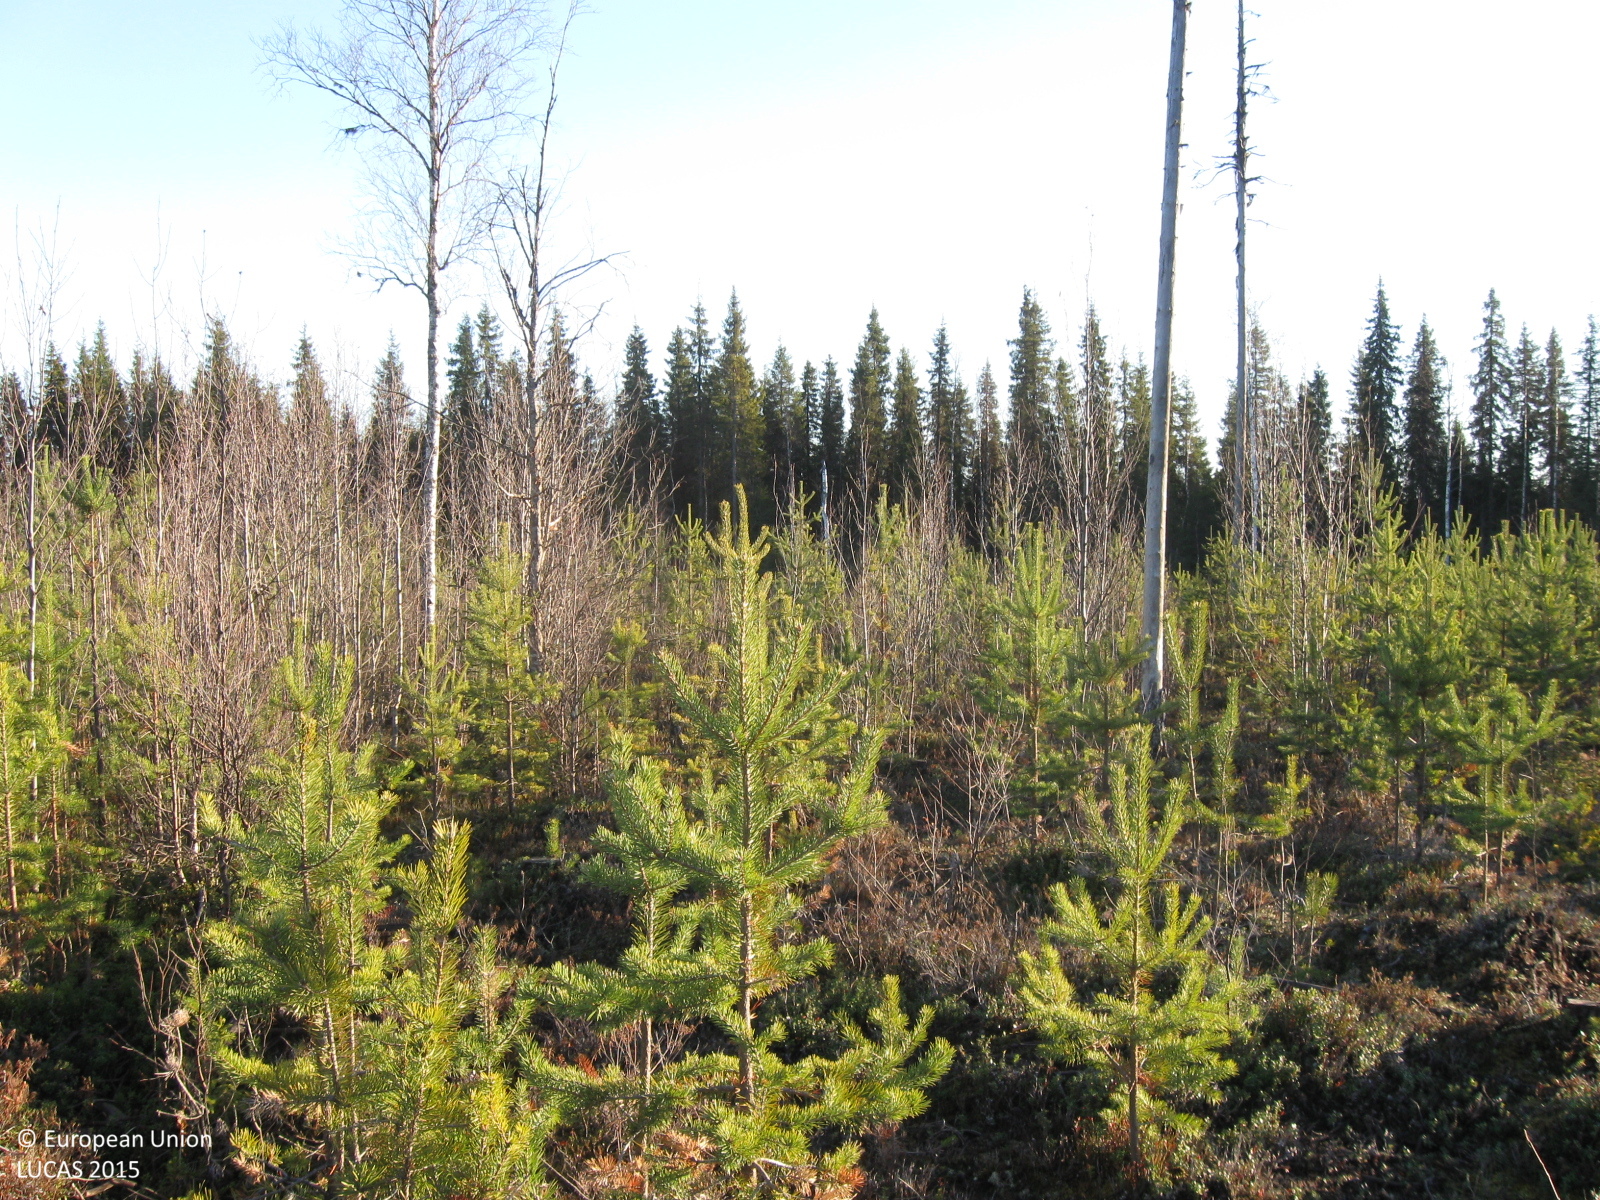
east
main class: Woodland
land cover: Pine dominated coniferous woodland
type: boreal forest
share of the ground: 25 - 50 %
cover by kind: coniferous forest trees 30 %, shrubs 20 %, herbaceous plants 10 %, lichens and mosses 10 %, consolidated bare surface 10 %, unconsolidated bare surface 10 %, broadleaved forest trees 5 %
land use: Forestry
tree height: < 5 m
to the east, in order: Pine dominated coniferous woodland; Pine dominated mixed woodland; Spruce dominated mixed woodland; Spruce dominated coniferous woodland; Spruce dominated mixed woodland; Spruce dominated coniferous woodland
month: November
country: SE
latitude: 66.1134
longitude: 20.7845
